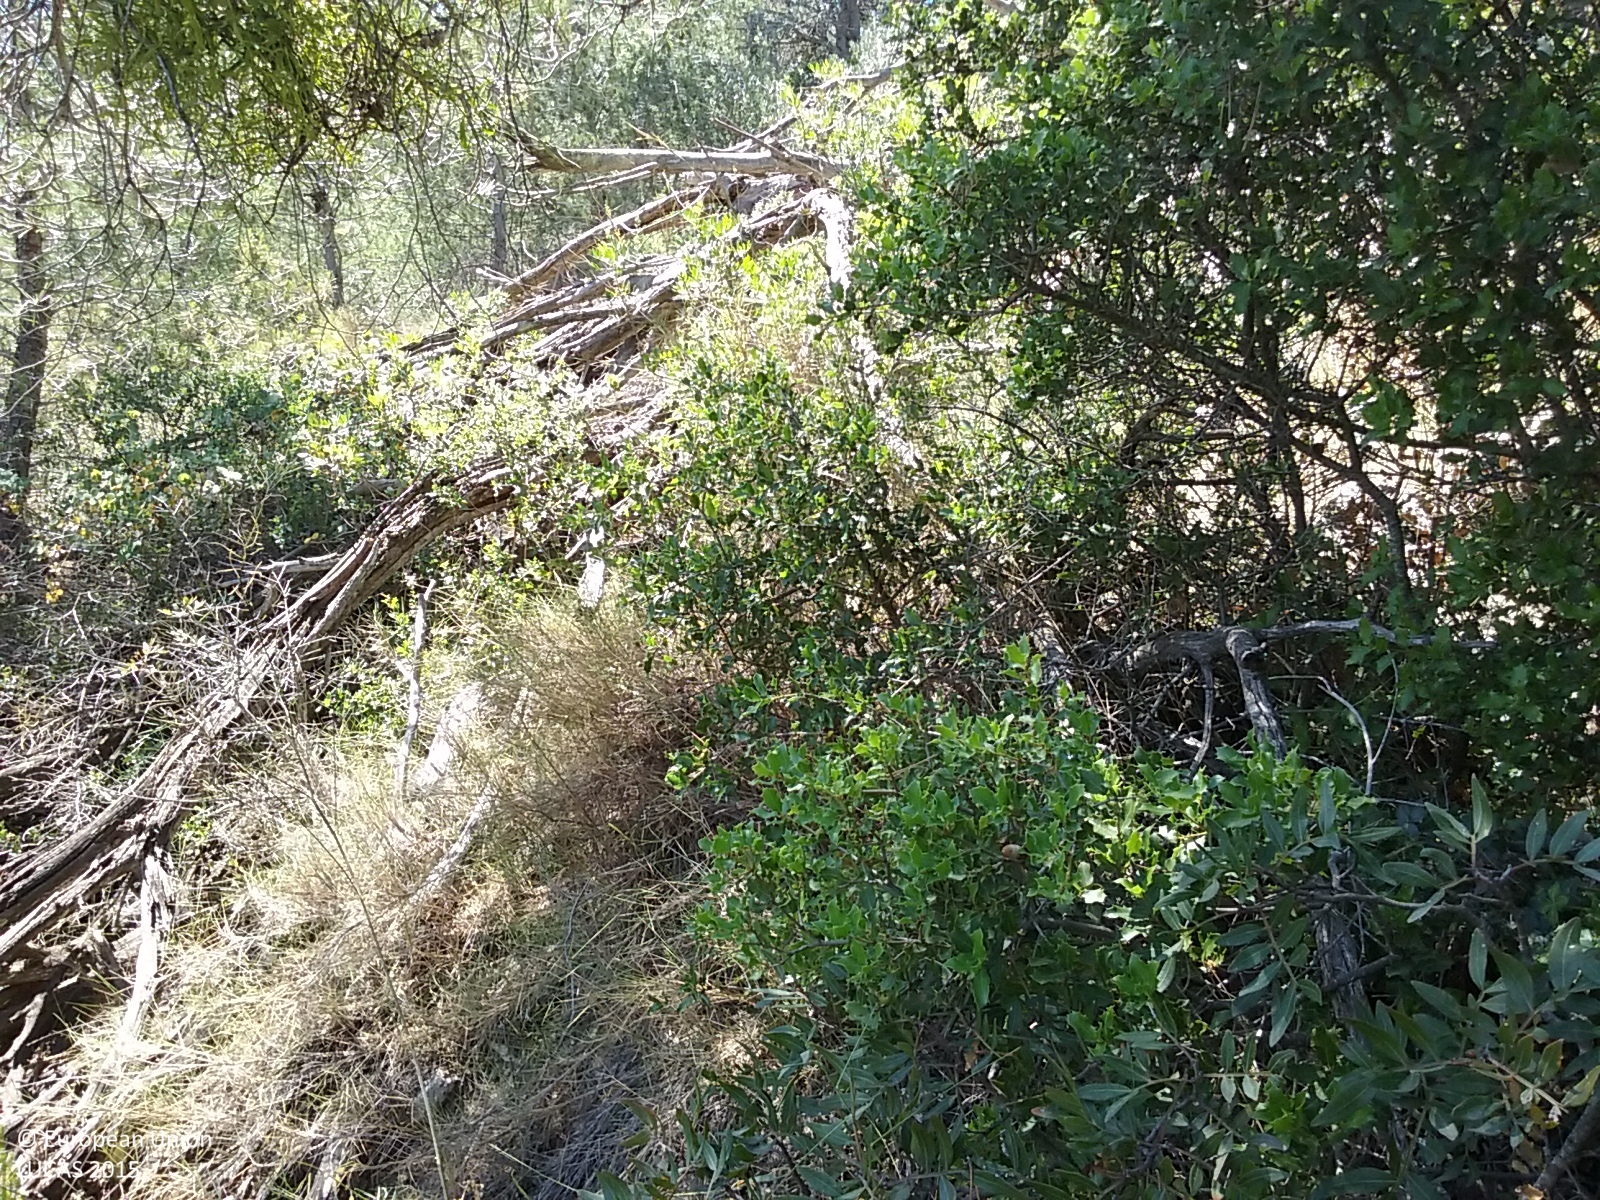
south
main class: Woodland
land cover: Pine dominated coniferous woodland
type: coniferous forest of the mediterranean region
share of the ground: > 75 %
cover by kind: coniferous forest trees 80 %, shrubs 20 %
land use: Semi-natural and natural areas not in use
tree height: > 5 m
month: June
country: ES
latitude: 41.2053
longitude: 0.4857
